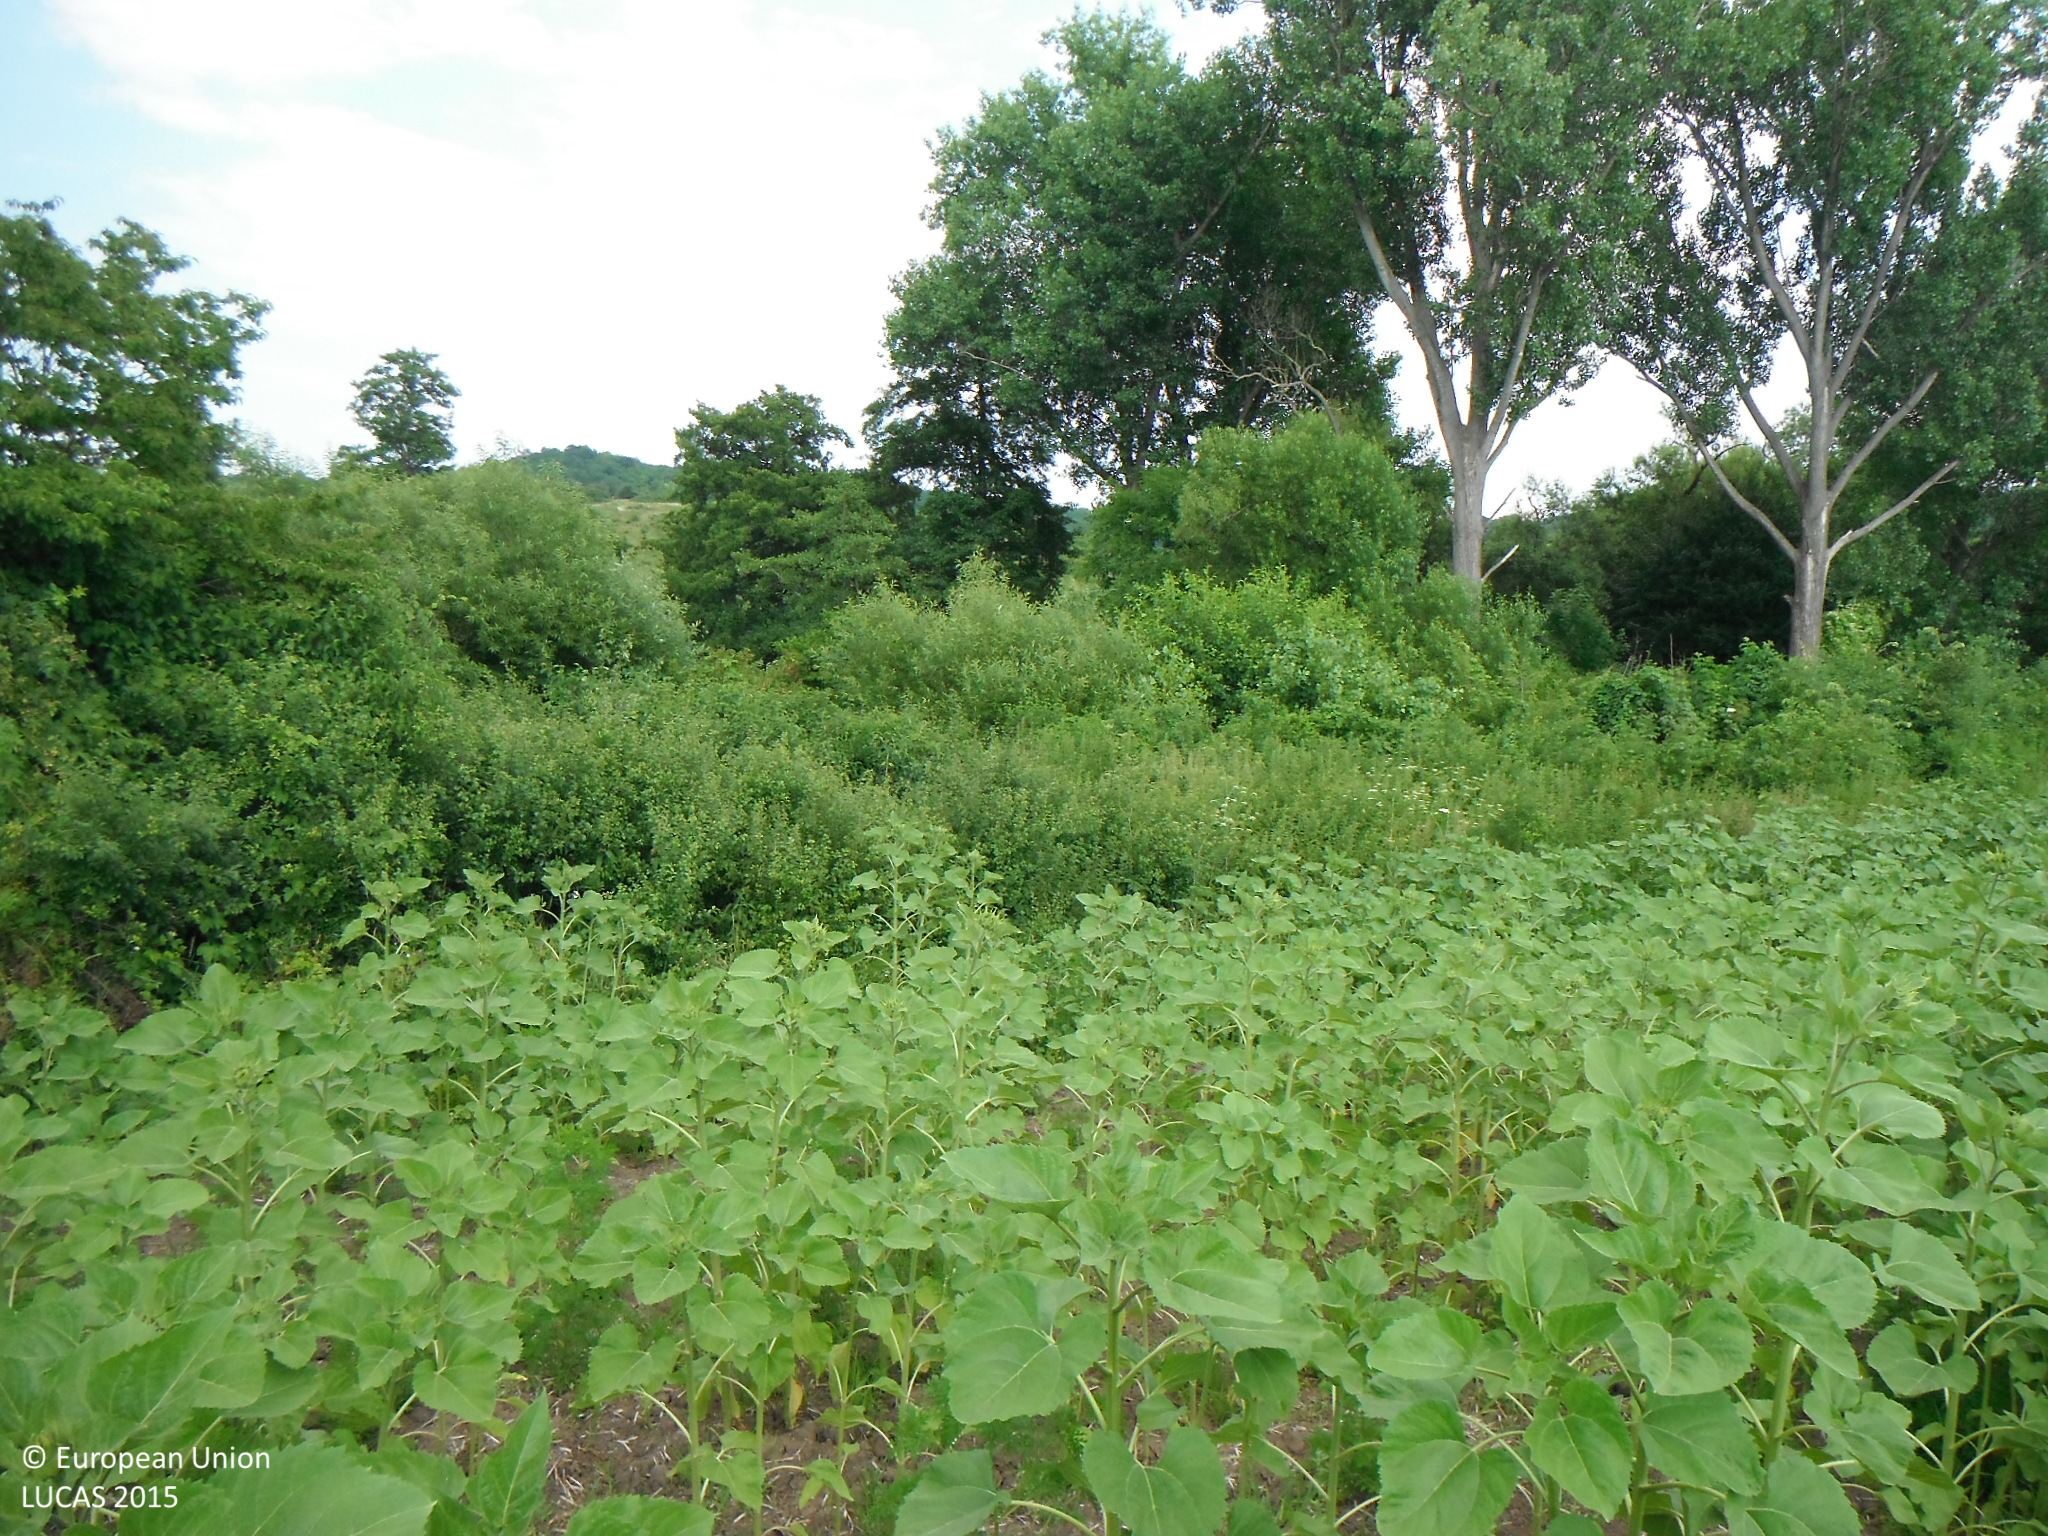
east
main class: Cropland
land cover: Sunflower
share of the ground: > 75 %
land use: Agriculture (excluding fallow land and kitchen gardens)
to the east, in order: Sunflower; Broadleaved woodland; Rivers and streams; Broadleaved woodland; Spontaneously vegetated surfaces; Sunflower; Other cereals; Electric lines; Other cereals
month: July
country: SK
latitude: 48.1035
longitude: 19.2746
